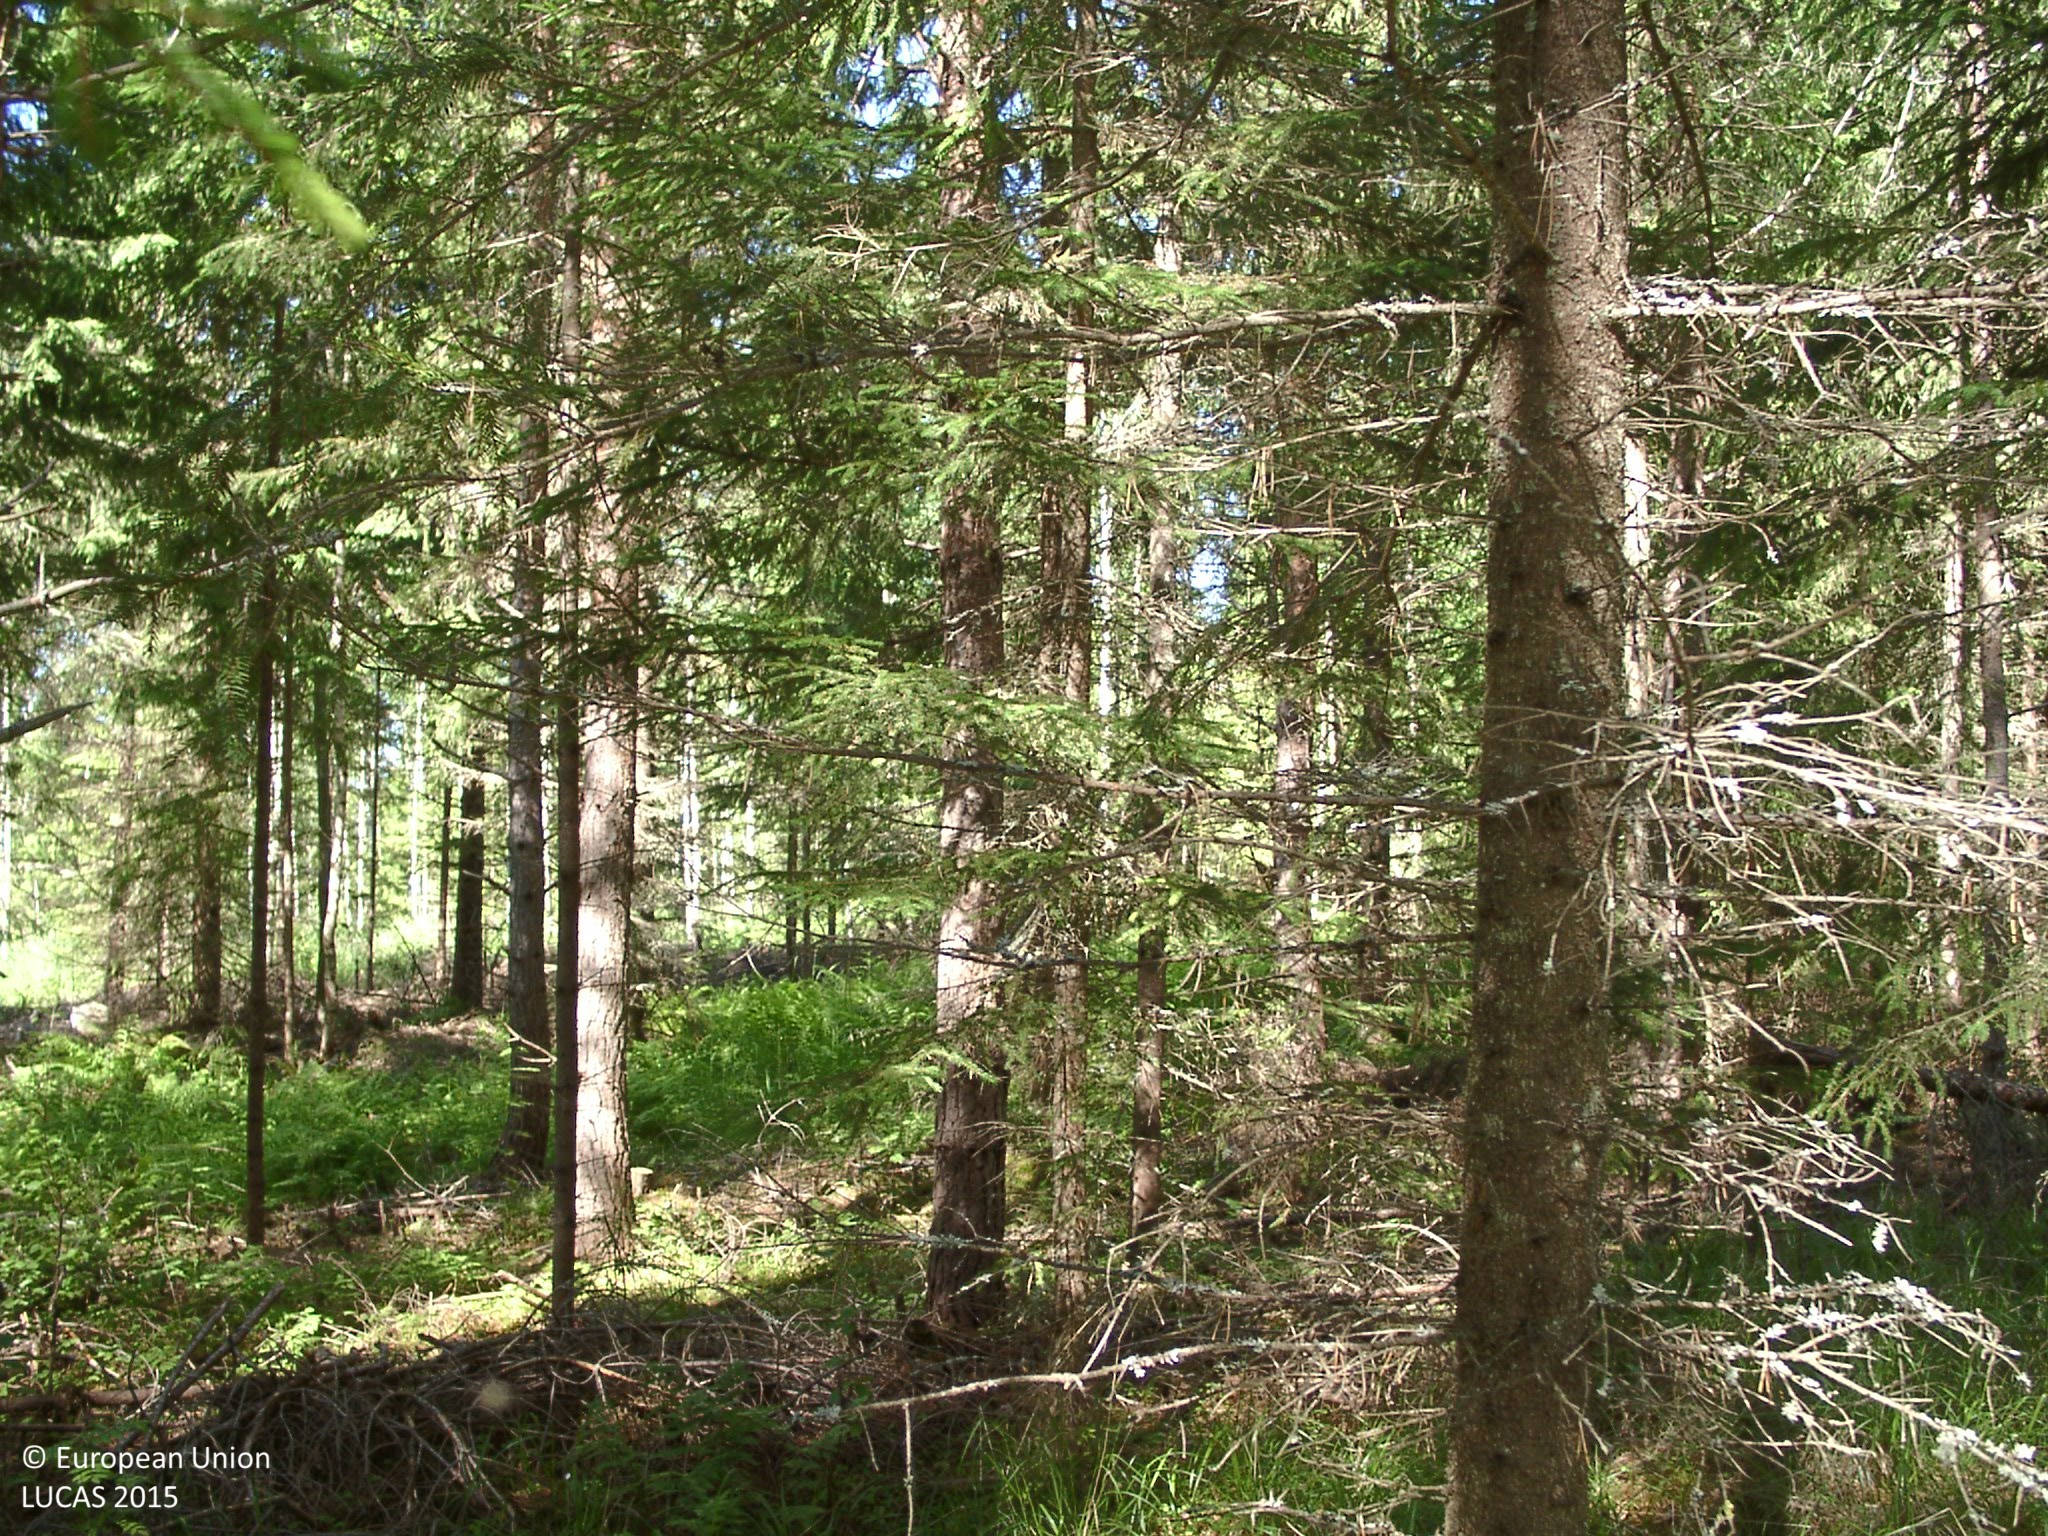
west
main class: Woodland
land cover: Other coniferous woodland
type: boreal forest
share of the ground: 50 - 75 %
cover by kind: coniferous forest trees 60 %, herbaceous plants 20 %, broadleaved forest trees 5 %, shrubs 5 %, lichens and mosses 5 %
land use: Forestry
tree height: > 5 m
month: June
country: FI
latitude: 62.1267
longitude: 25.0408
